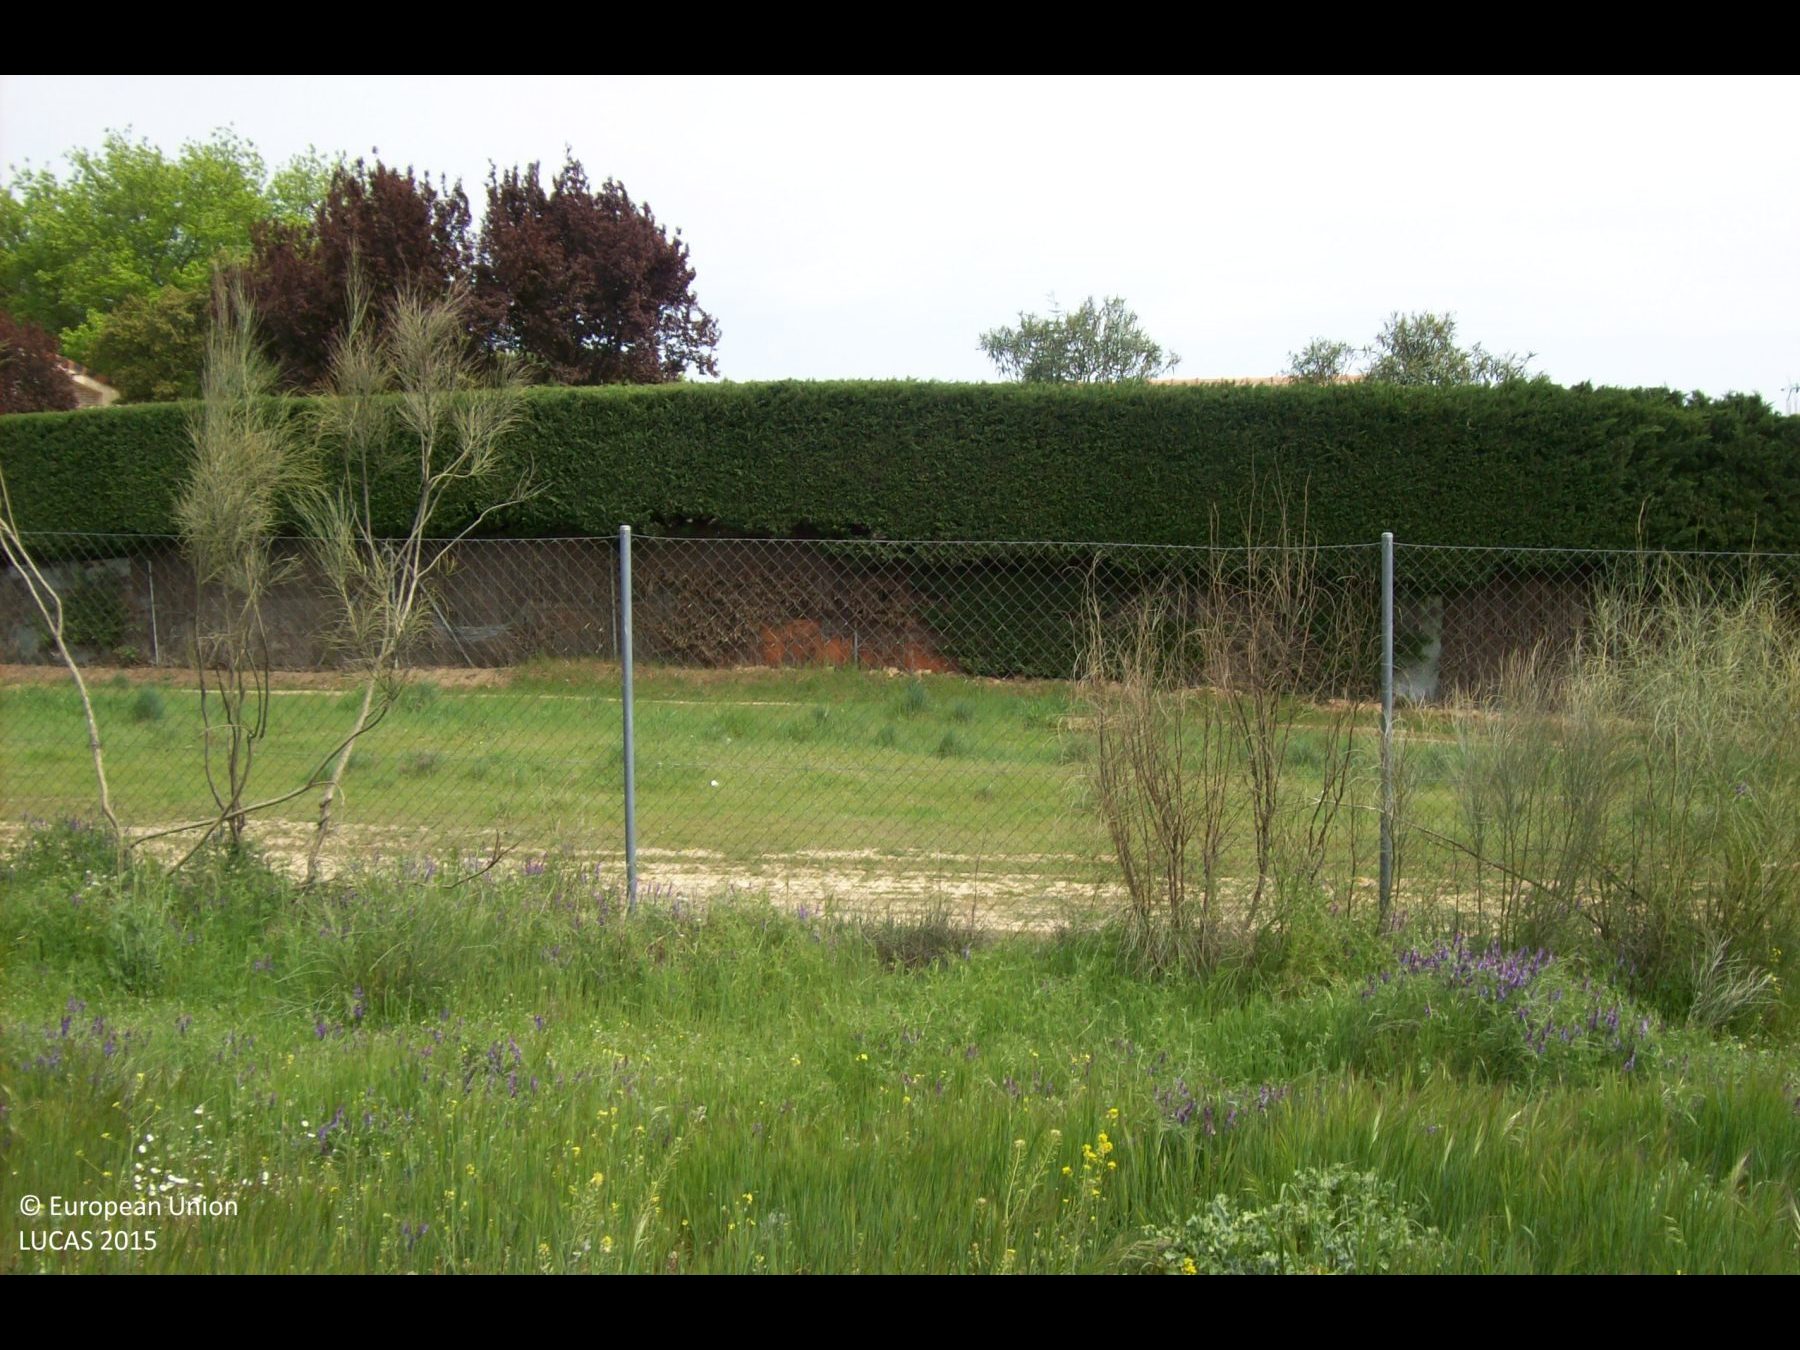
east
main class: Grassland
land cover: Grassland with sparse tree/shrub cover
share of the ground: > 75 %
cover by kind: herbaceous plants 95 %, broadleaved forest trees 5 %
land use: Semi-natural and natural areas not in use
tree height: < 5 m
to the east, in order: Grassland with sparse tree/shrub cover; Fences; Grass margins; Tracks; Grassland without tree/shrub cover; Artificial constructions in urban areas
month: April
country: ES
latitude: 40.4284
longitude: -3.8903
